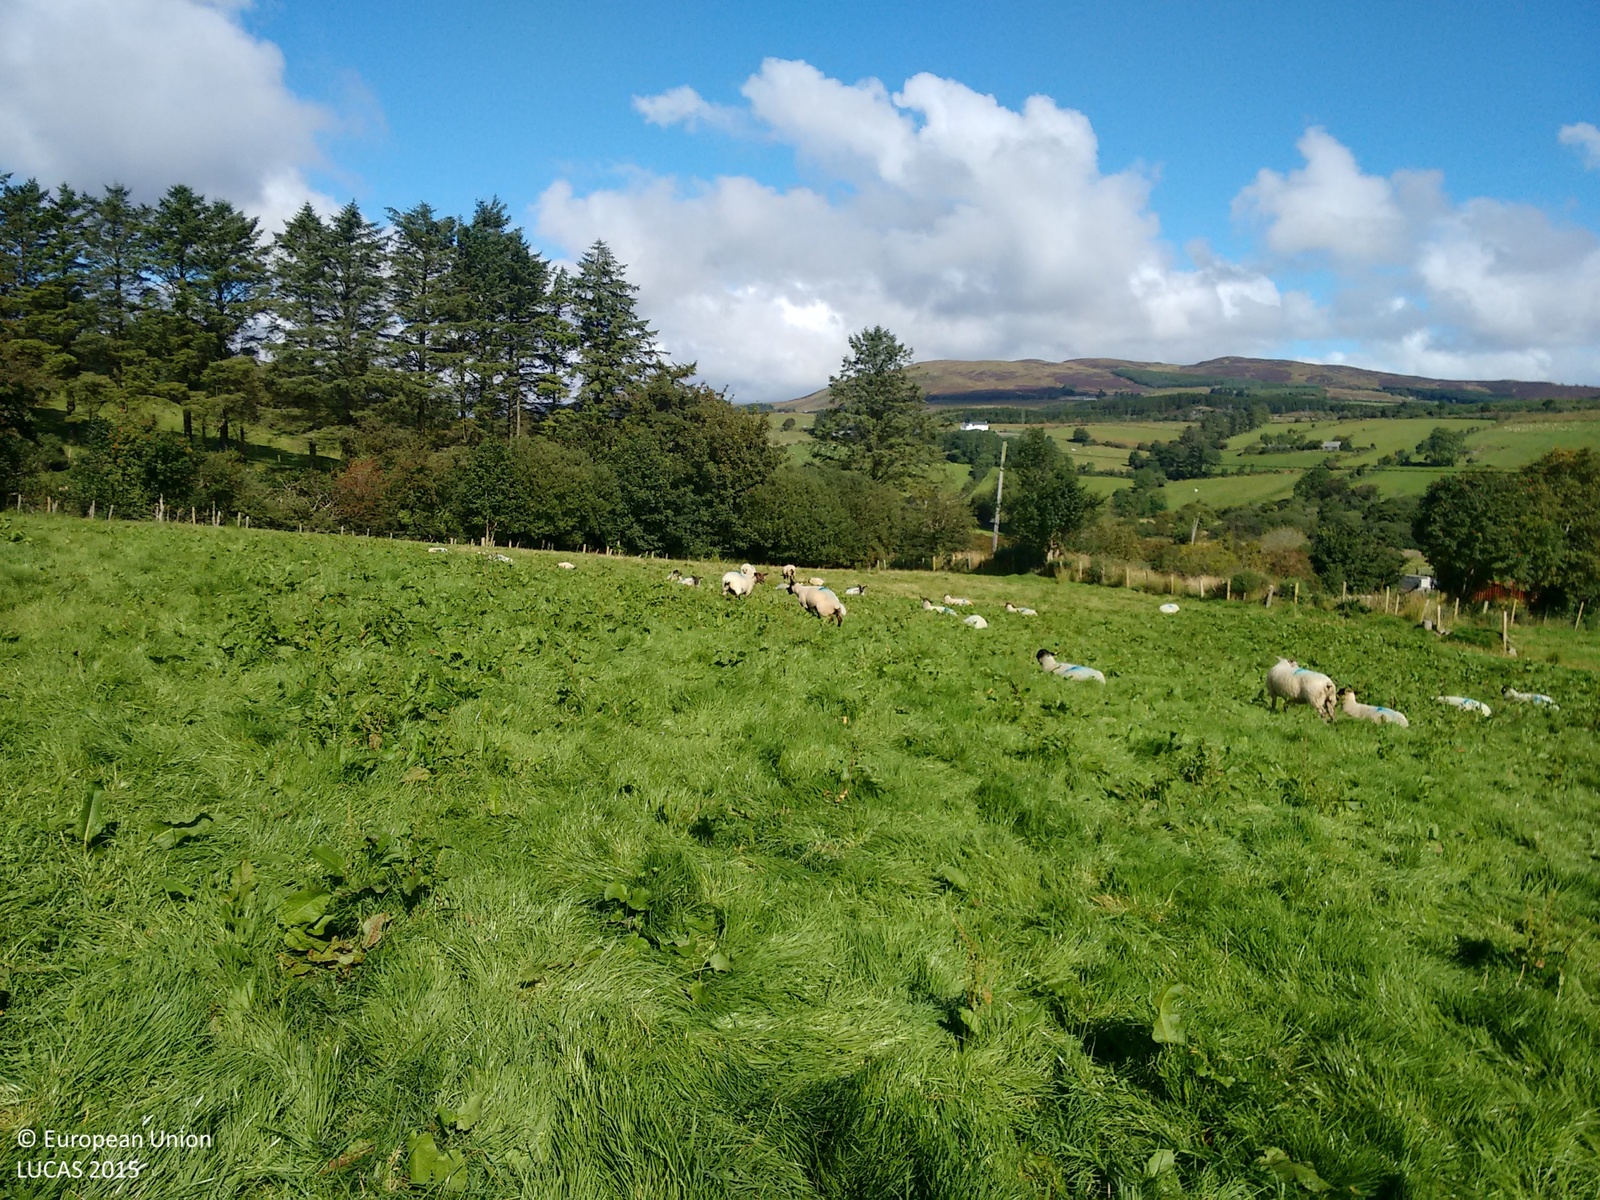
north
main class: Grassland
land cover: Grassland without tree/shrub cover
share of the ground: > 75 %
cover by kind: herbaceous plants 100 %
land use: Agriculture (excluding fallow land and kitchen gardens)
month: September
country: IE
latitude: 55.1379
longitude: -7.2276
